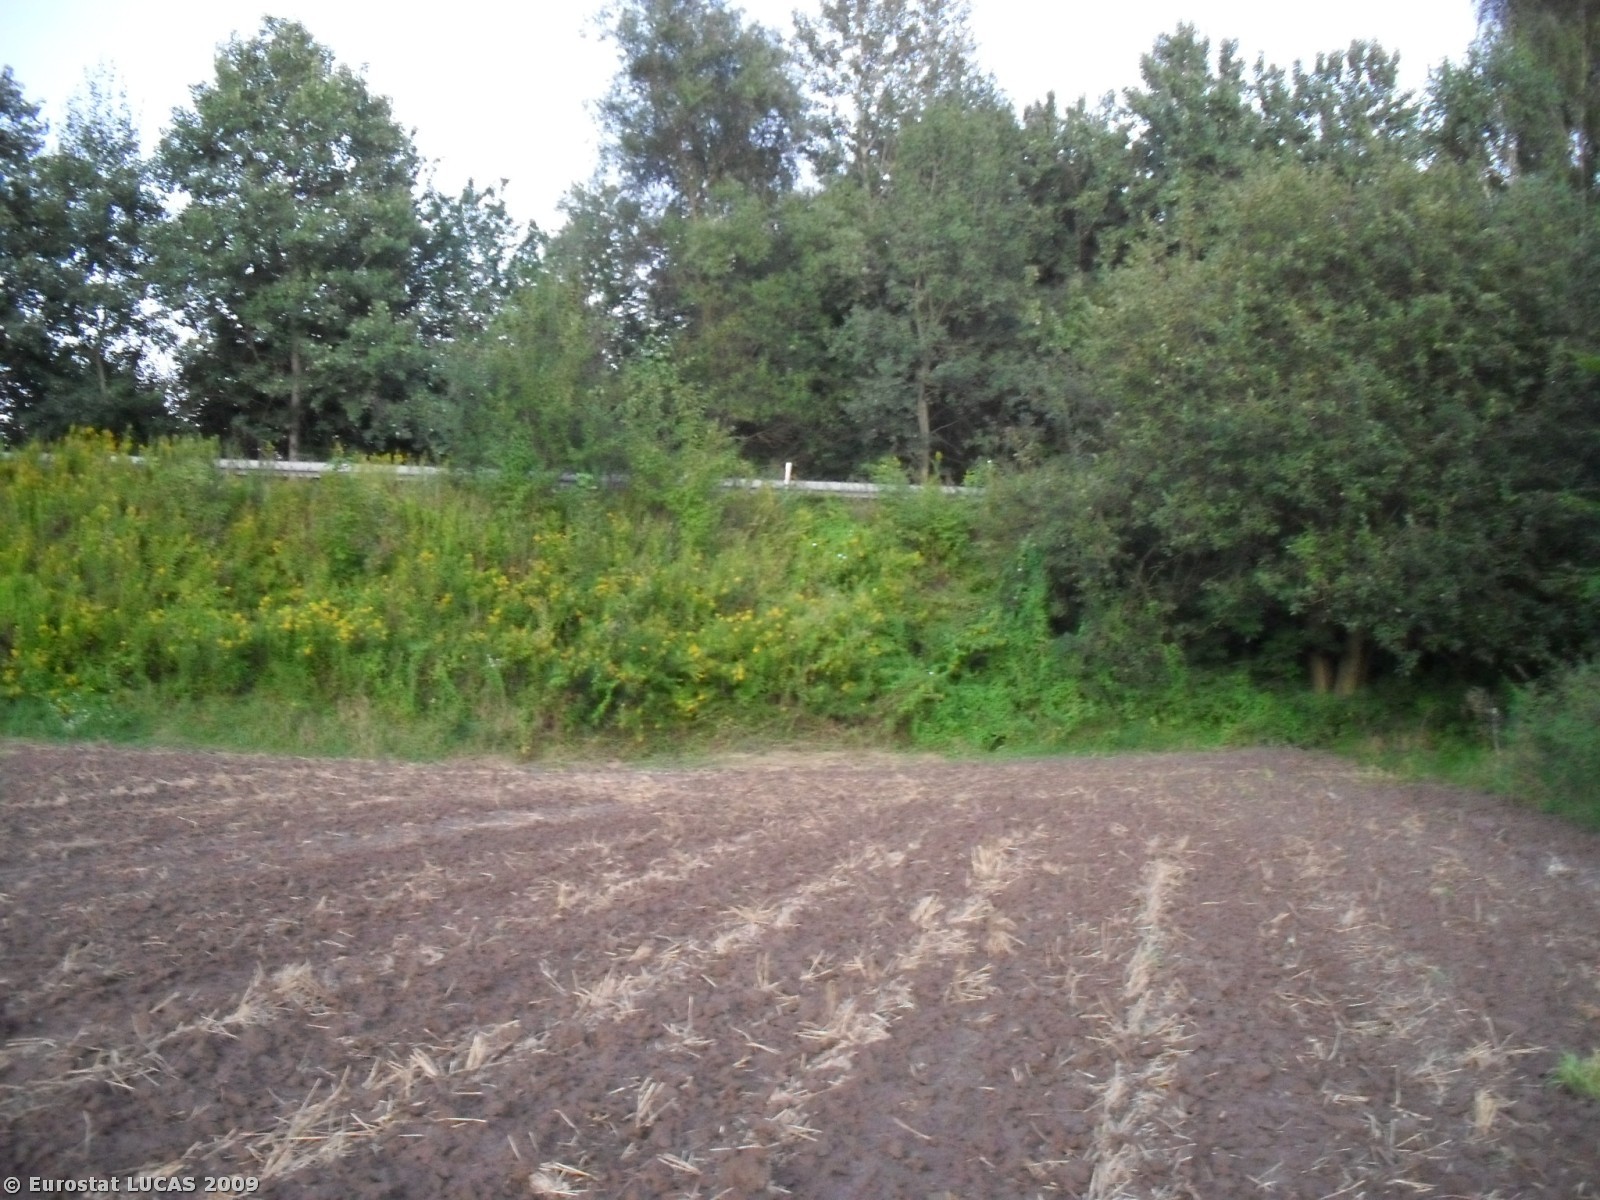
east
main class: Cropland
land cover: Common wheat
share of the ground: < 10 %
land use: Agriculture (excluding fallow land and kitchen gardens)
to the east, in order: Common wheat; Spontaneously vegetated surfaces; Grass margins; Paved roads, cycling and walking lanes; Broadleaved woodland; Tracks; Broadleaved woodland; Strawberries; Abandoned hedges; Tracks; Other fruit trees and berries
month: August
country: PL
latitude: 51.3106
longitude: 22.0088
